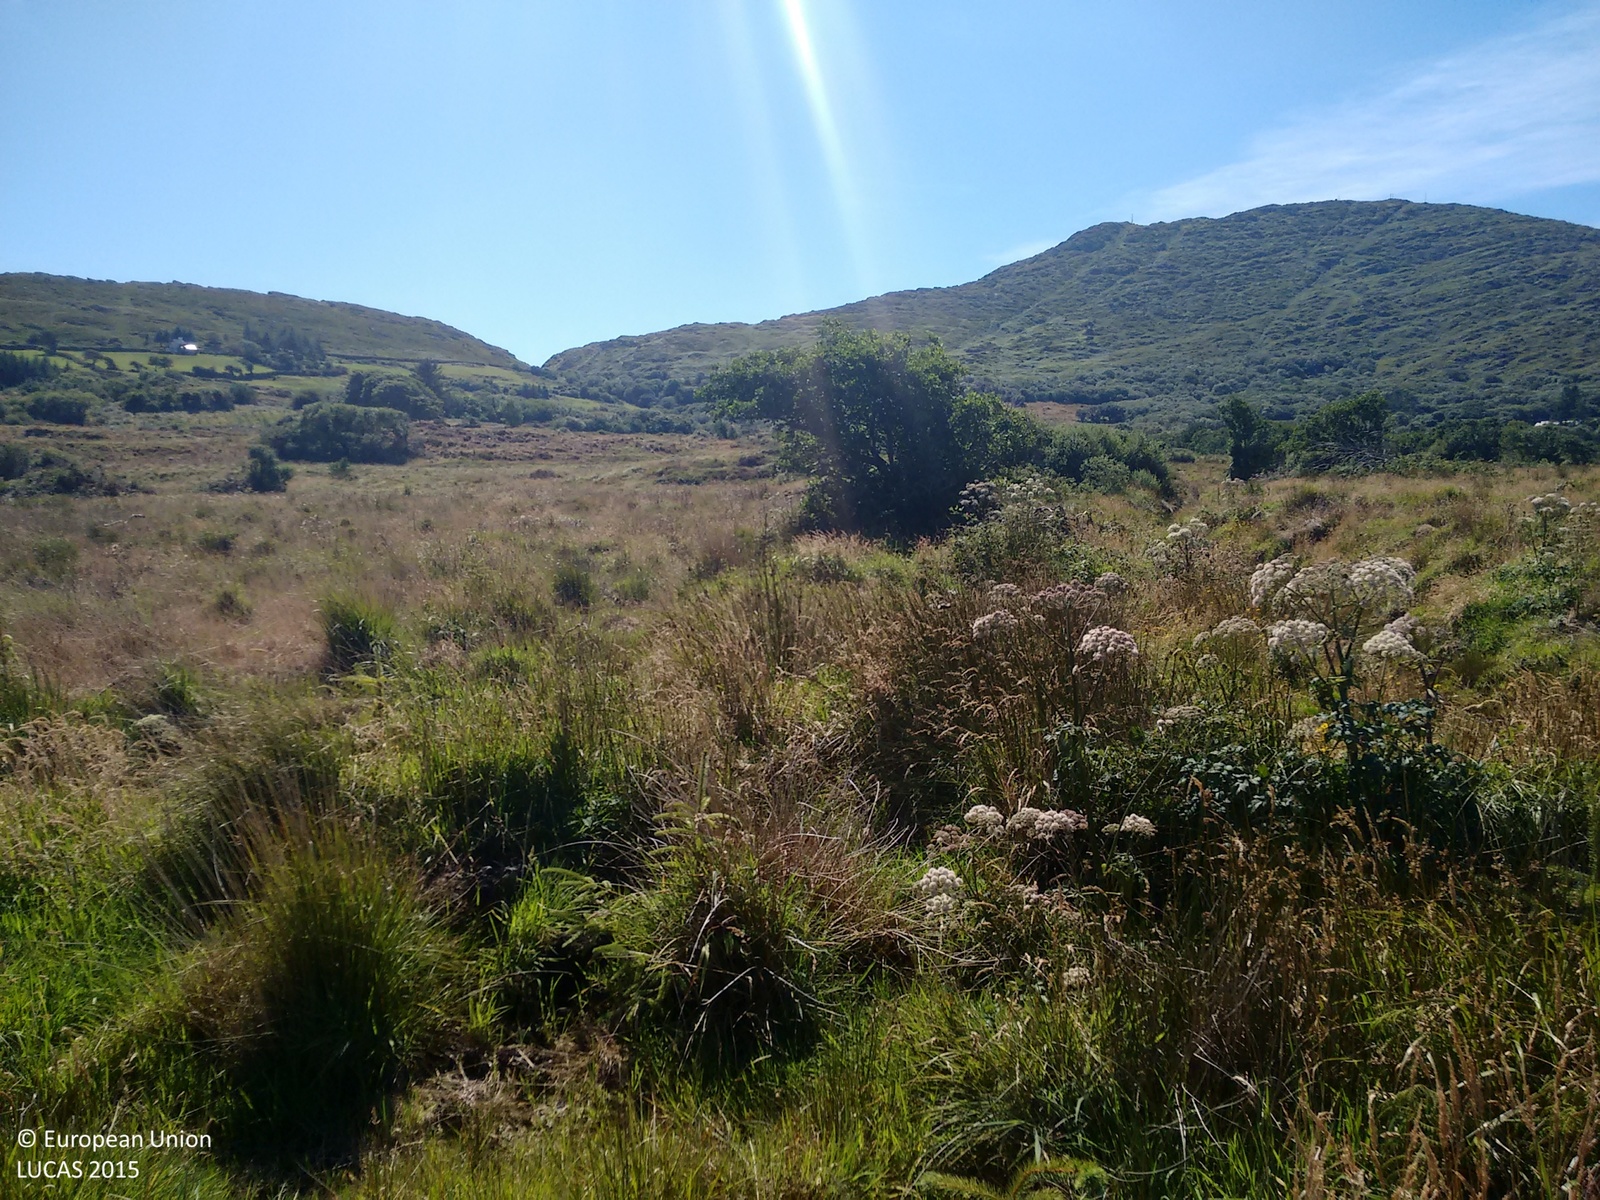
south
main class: Woodland
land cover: Spruce dominated coniferous woodland
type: exotic forest
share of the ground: > 75 %
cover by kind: coniferous forest trees 50 %, herbaceous plants 50 %
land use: Forestry
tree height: < 5 m
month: August
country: IE
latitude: 51.5664
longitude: -9.5219
